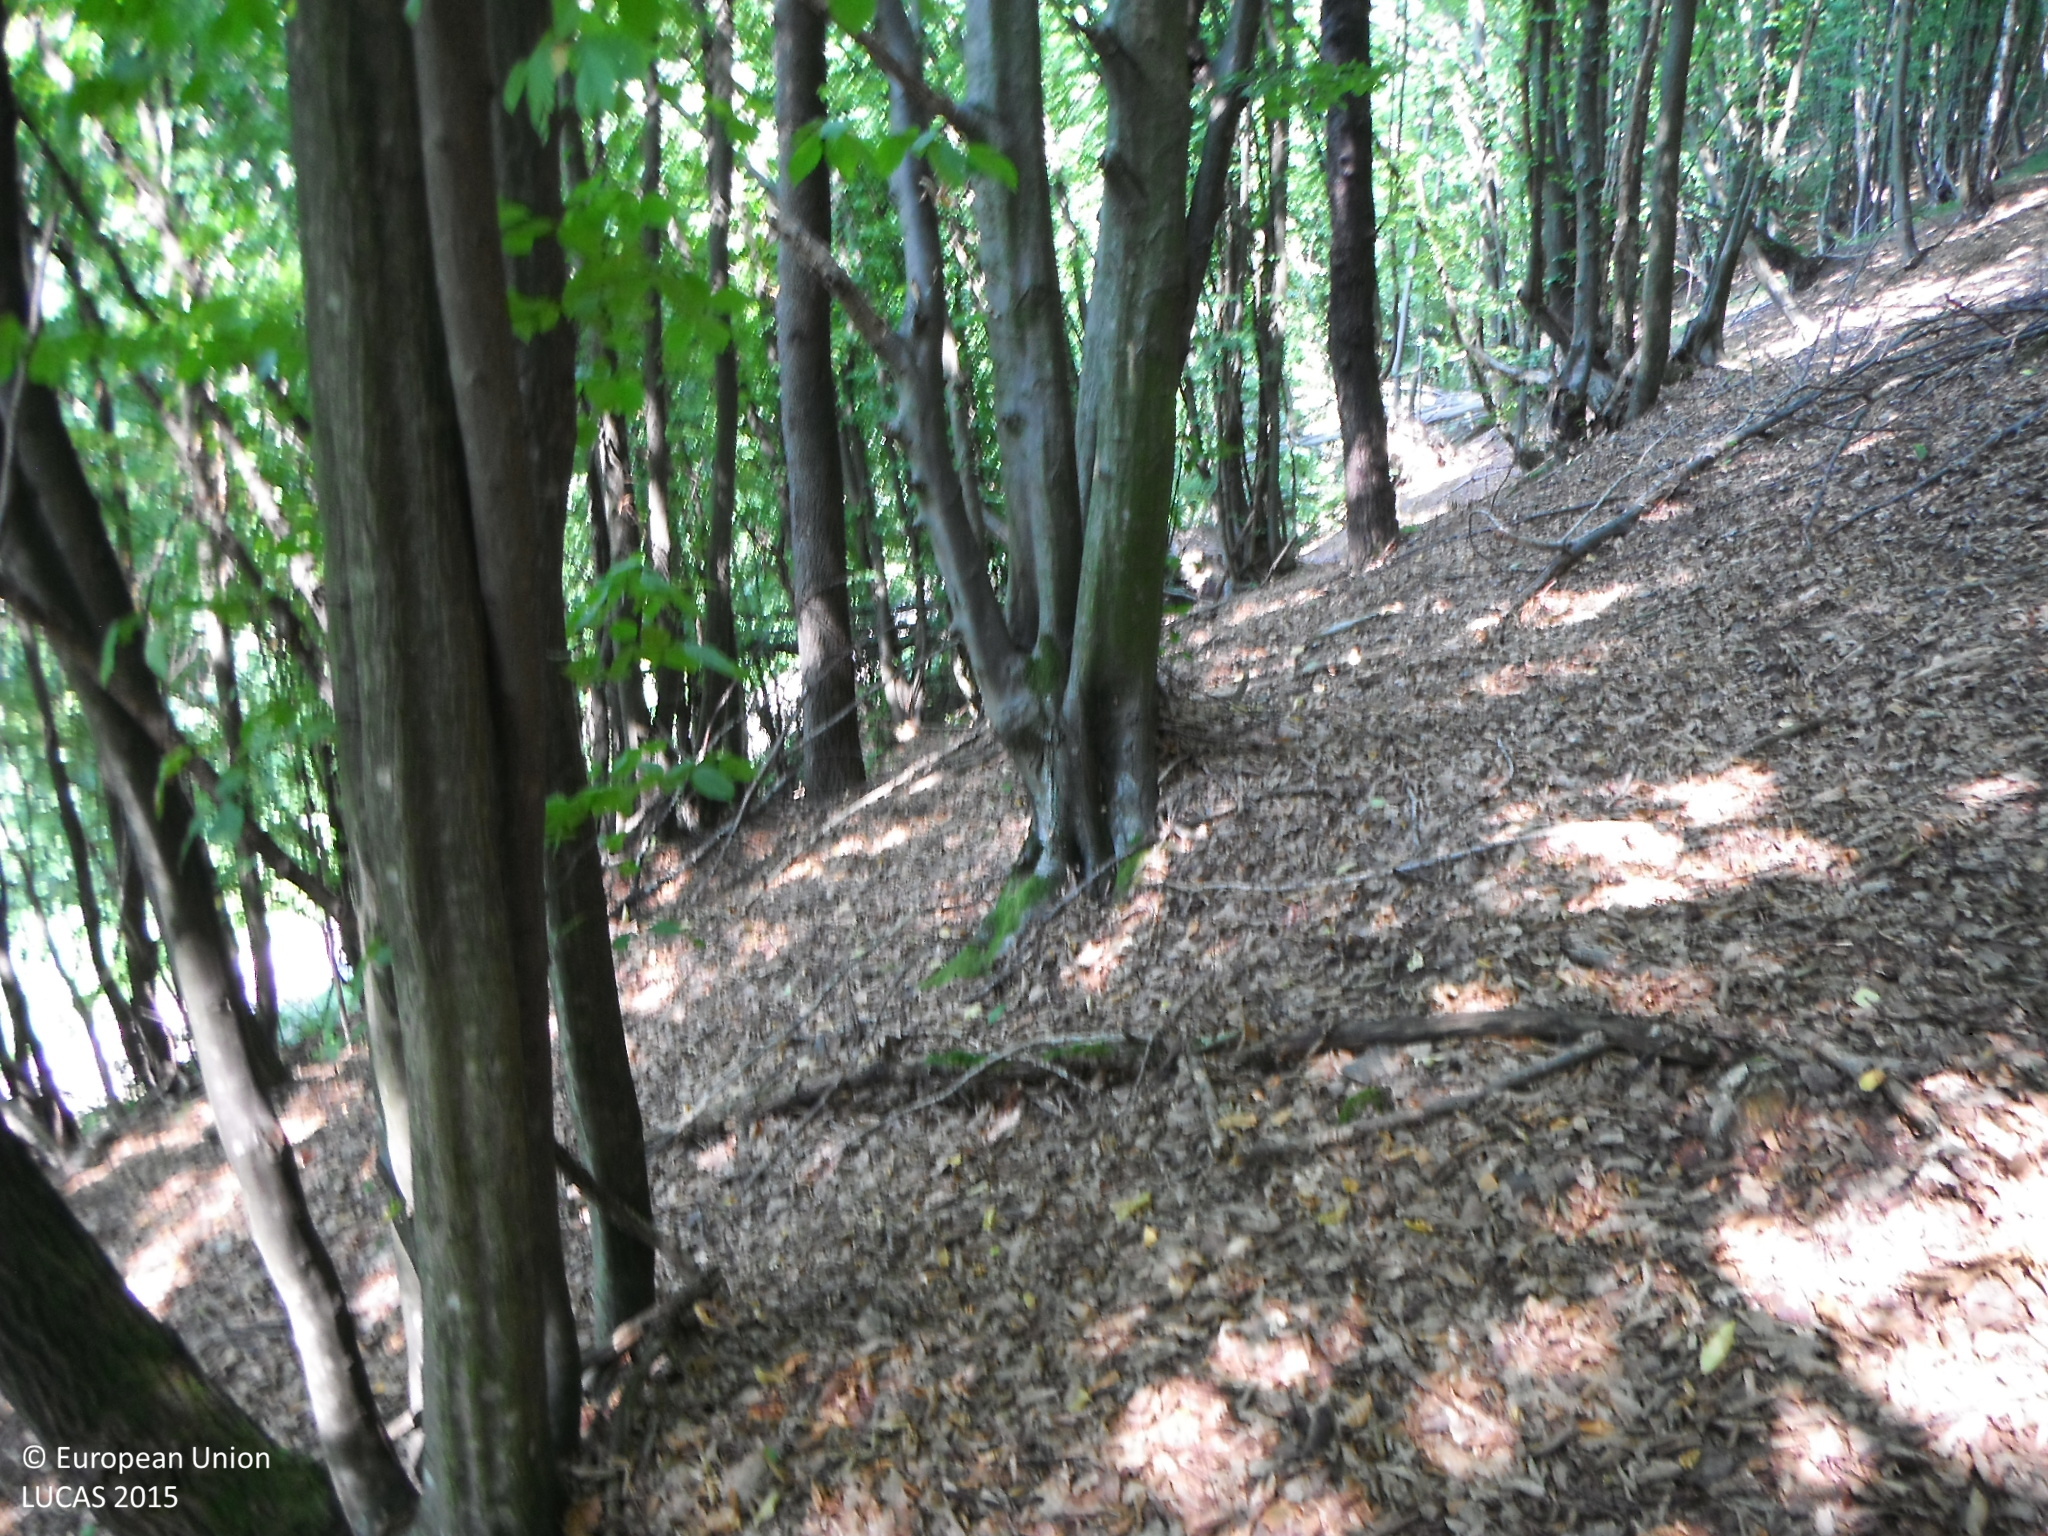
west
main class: Woodland
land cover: Broadleaved woodland
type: beech forest
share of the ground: > 75 %
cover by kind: broadleaved forest trees 100 %
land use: Forestry
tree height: > 5 m
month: August
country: SK
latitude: 48.7552
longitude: 20.3030
